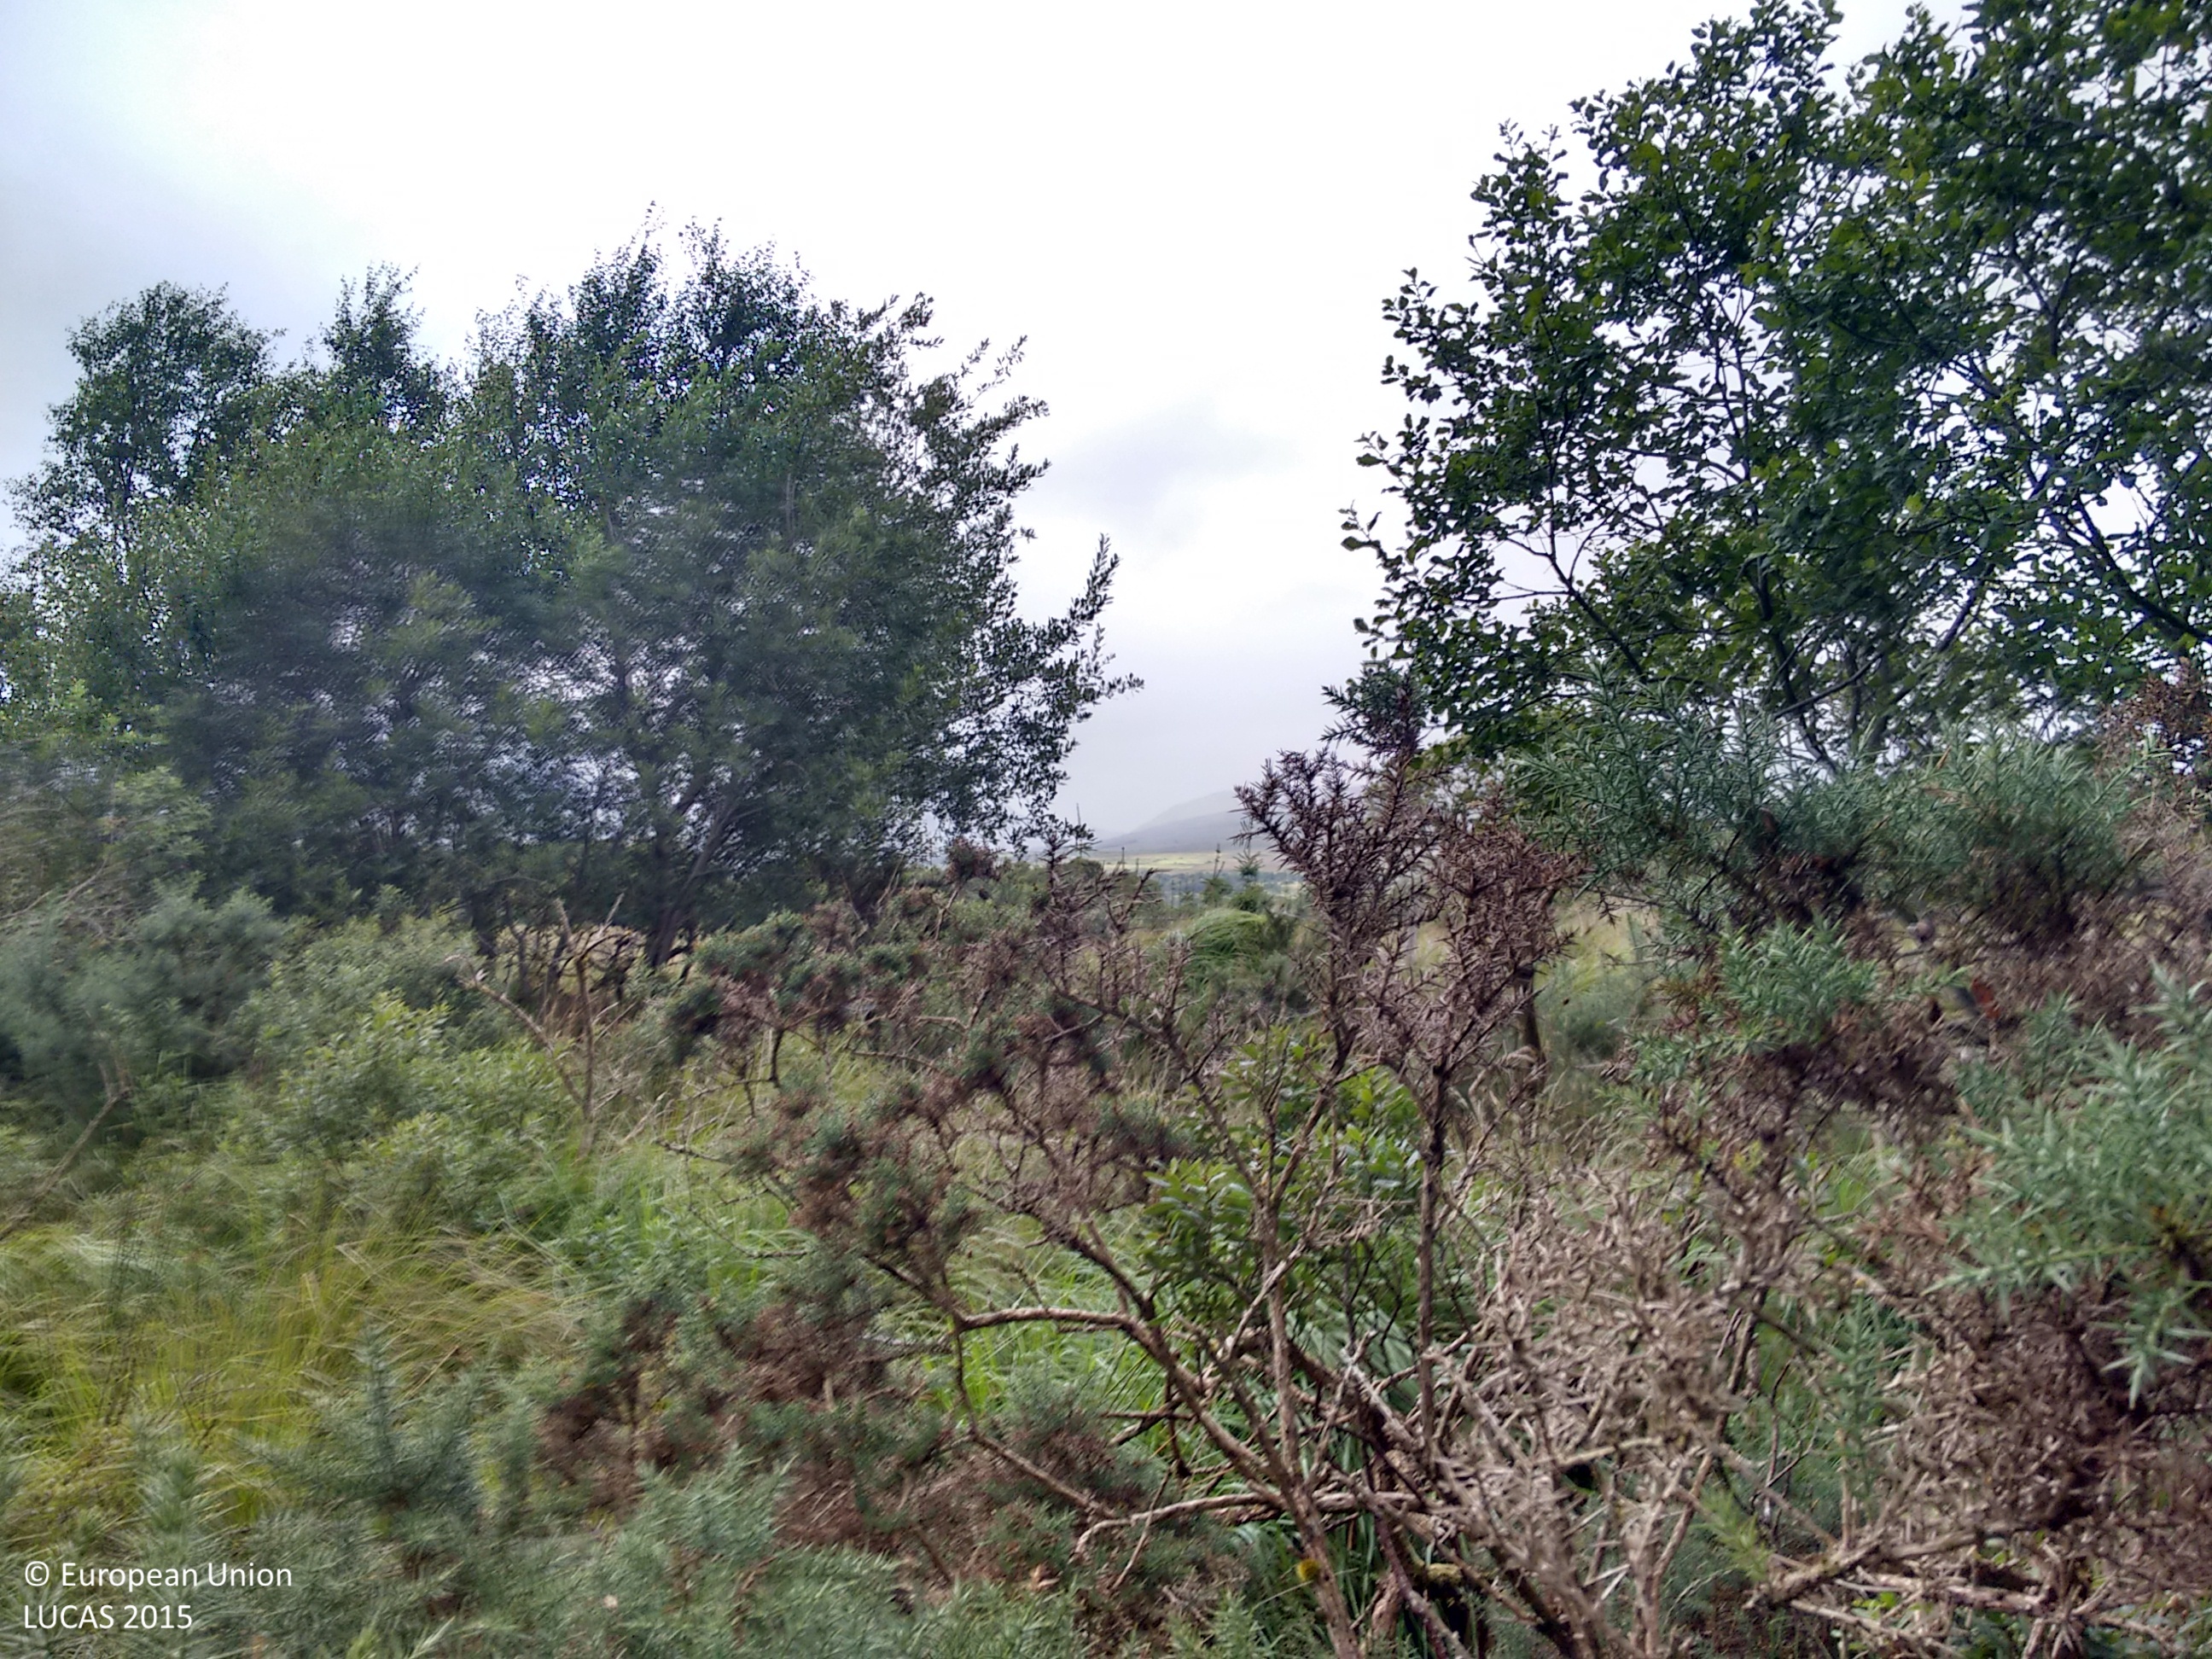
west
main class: Shrubland
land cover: Shrubland with sparse tree cover
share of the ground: > 75 %
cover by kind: shrubs 55 %, herbaceous plants 40 %, broadleaved forest trees 5 %
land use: Forestry
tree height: > 5 m
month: August
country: IE
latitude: 51.8832
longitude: -9.5120
